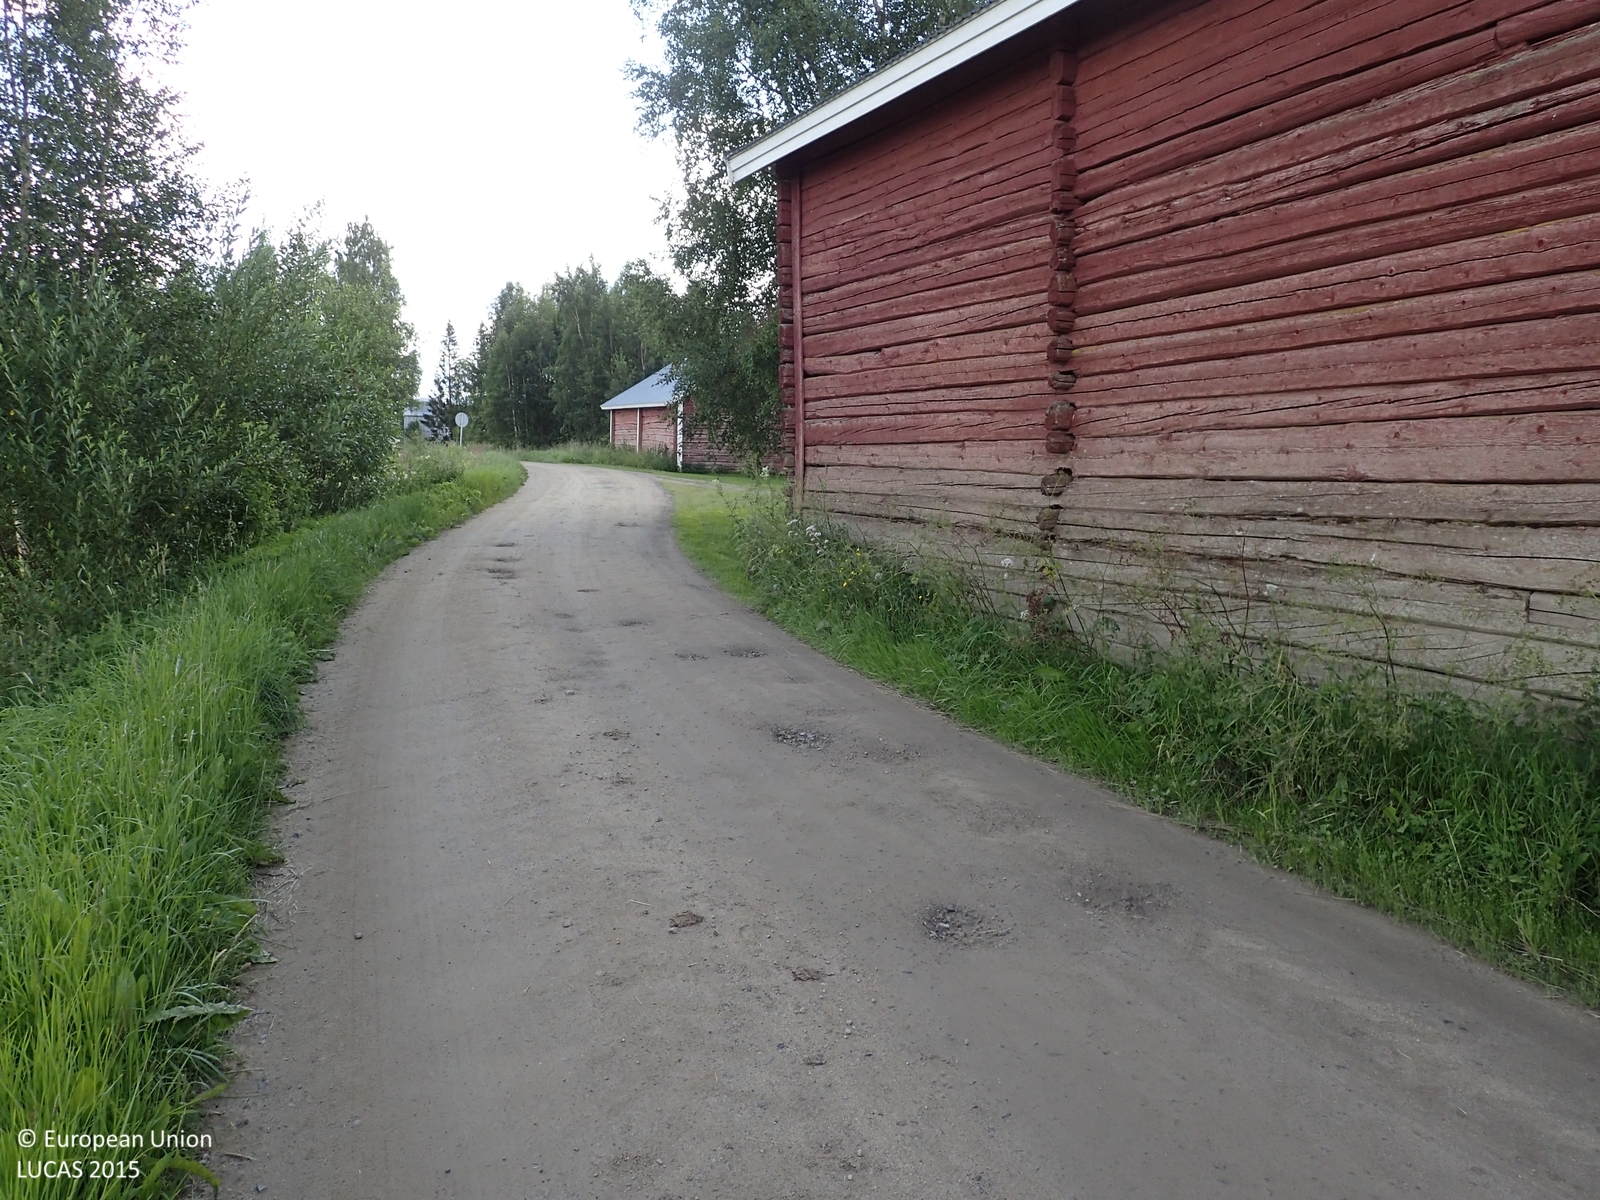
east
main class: Cropland
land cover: Temporary grasslands
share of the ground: > 75 %
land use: Agriculture (excluding fallow land and kitchen gardens)
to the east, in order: Temporary grasslands; Fences; Ditches and canals; Shruby margins; Barley; Ditches and canals; Lines of trees; Temporary grasslands; Electric lines; Ditches and canals; Grass margins; Paved roads, cycling and walking lanes; Grass margins; Ditches and canals; Abandoned hedges; Other fresh vegetables
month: August
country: FI
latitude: 62.7220
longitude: 21.9181
